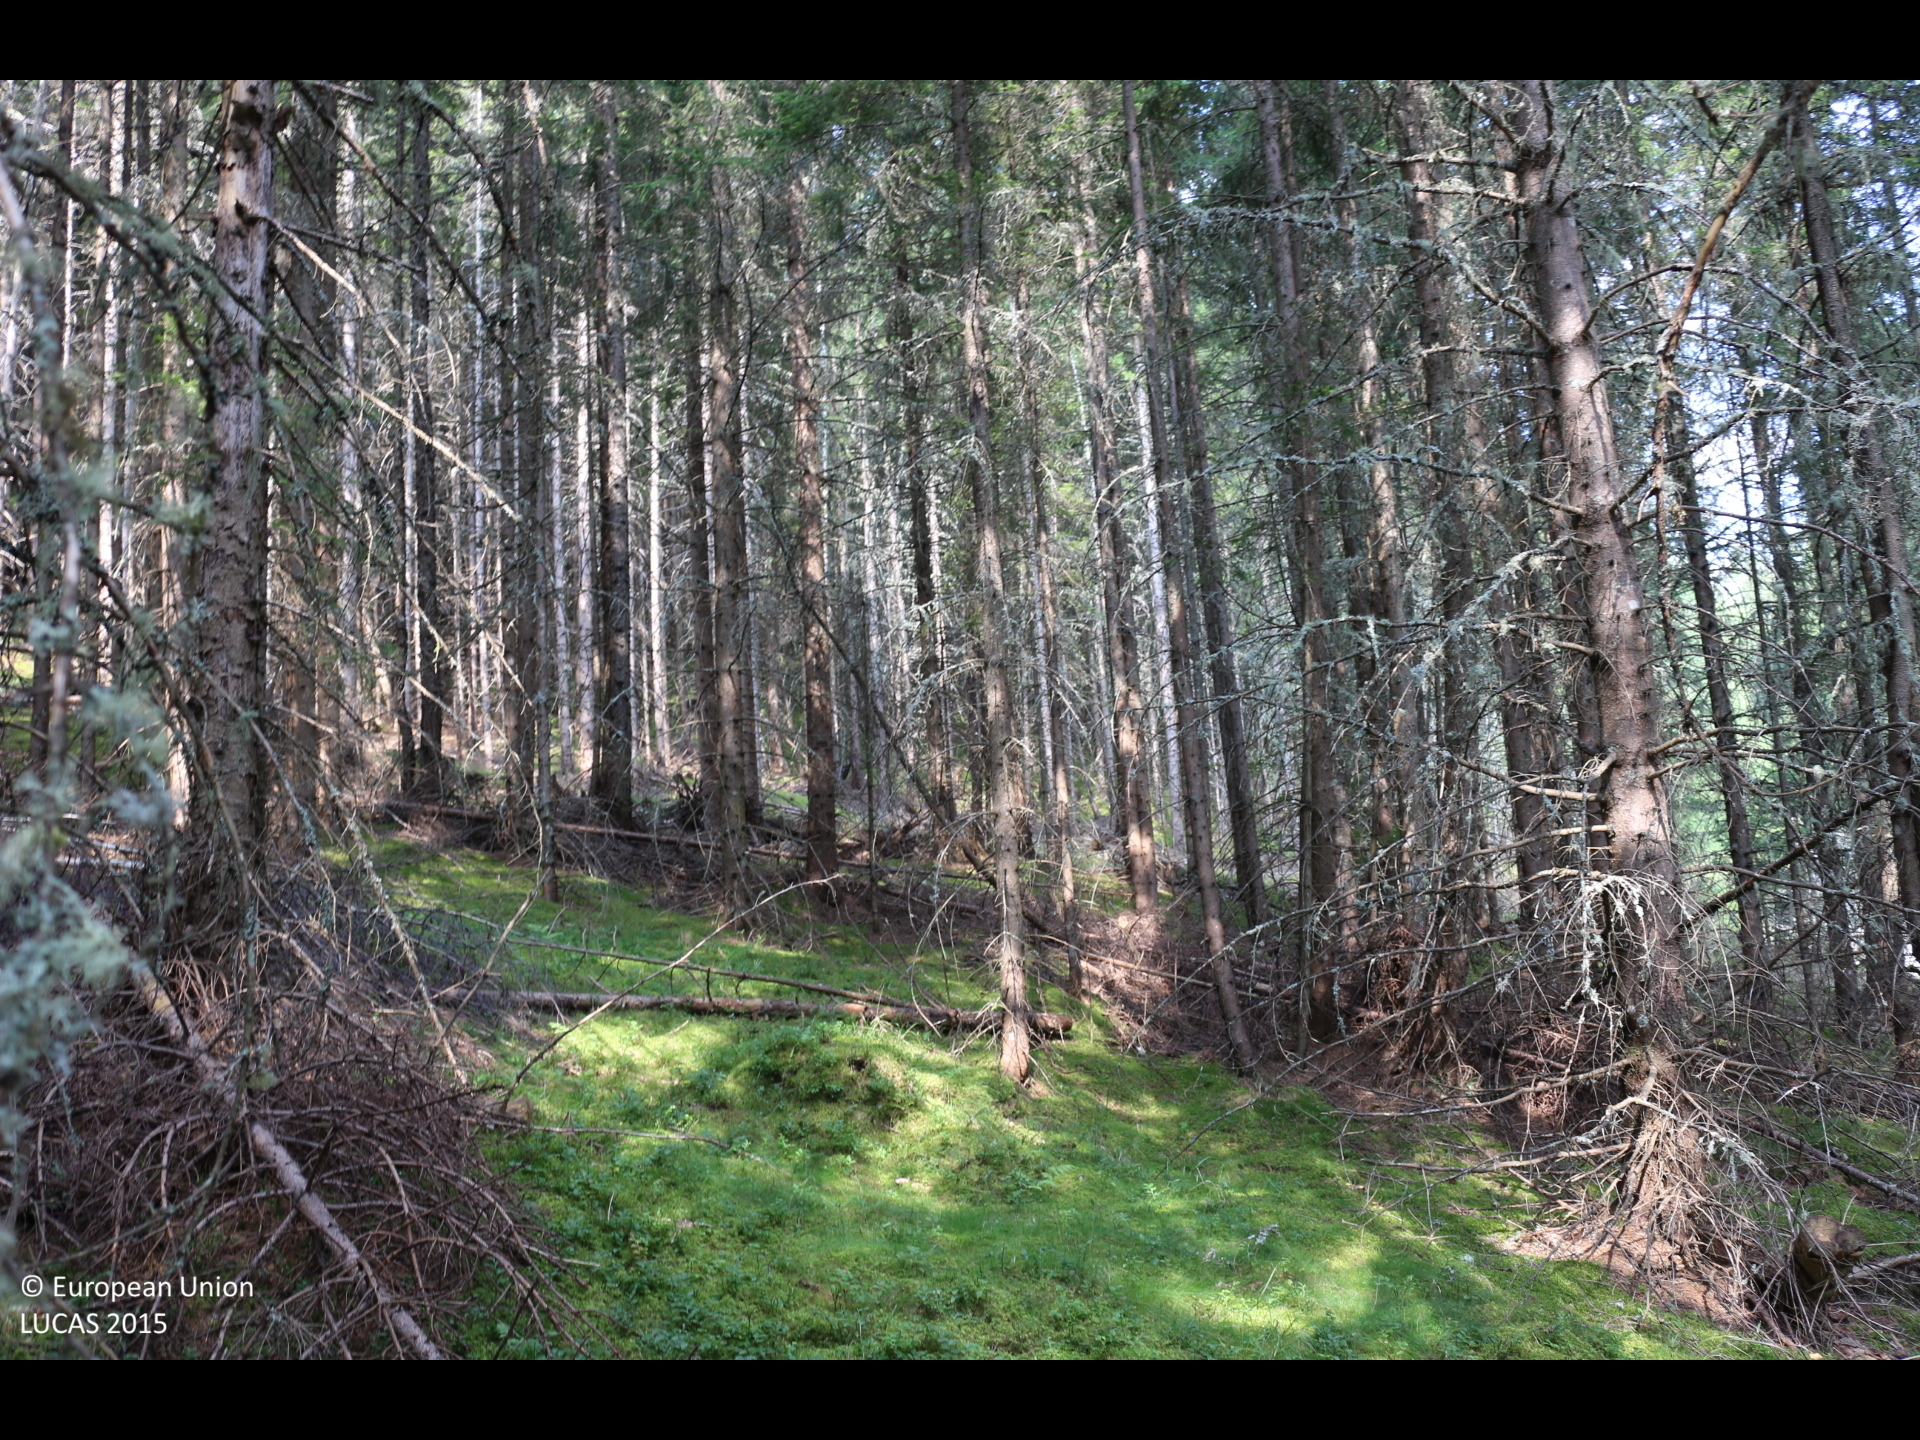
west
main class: Woodland
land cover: Spruce dominated coniferous woodland
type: alpine coniferous forest
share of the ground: > 75 %
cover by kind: coniferous forest trees 90 %, lichens and mosses 10 %
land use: Forestry
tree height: > 5 m
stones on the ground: < 10 %
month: August
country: AT
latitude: 46.9744
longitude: 14.1386
